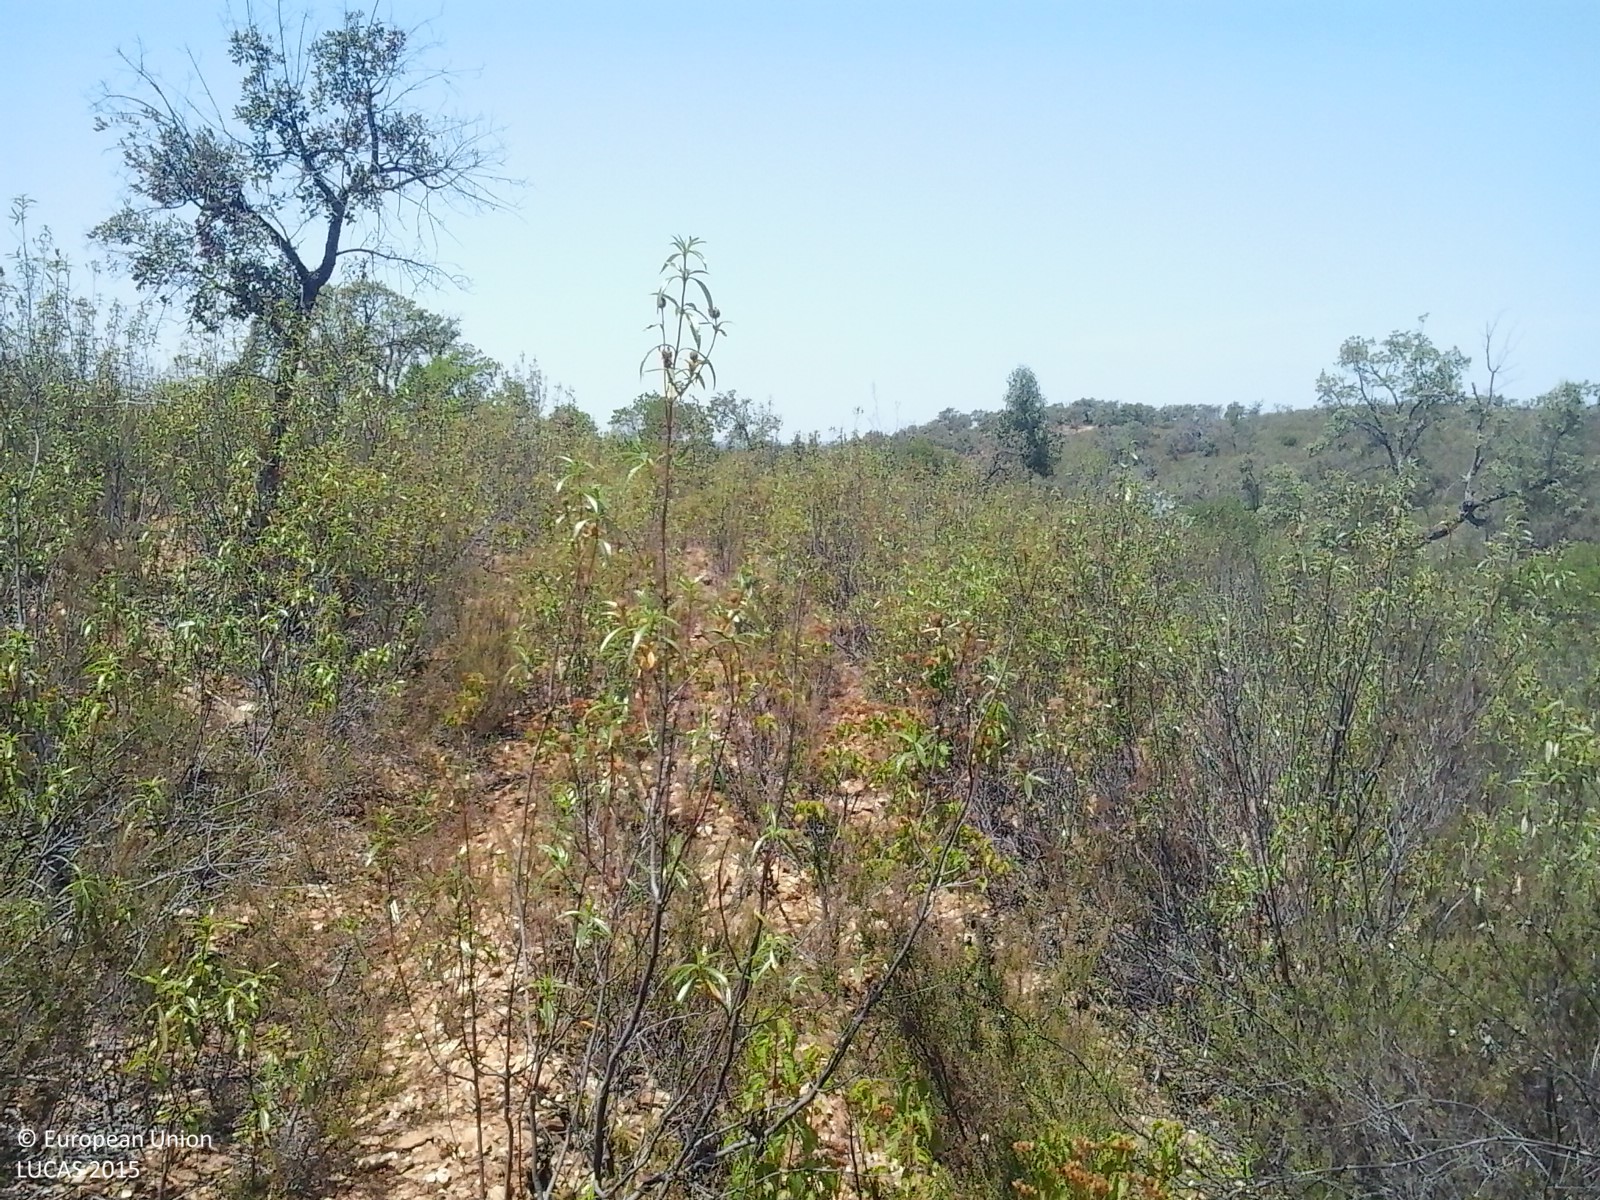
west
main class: Shrubland
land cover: Shrubland without tree cover
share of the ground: > 75 %
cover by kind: shrubs 90 %, herbaceous plants 5 %, unconsolidated bare surface 5 %
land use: Forestry
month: July
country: ES
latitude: 37.5573
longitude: -6.4606
